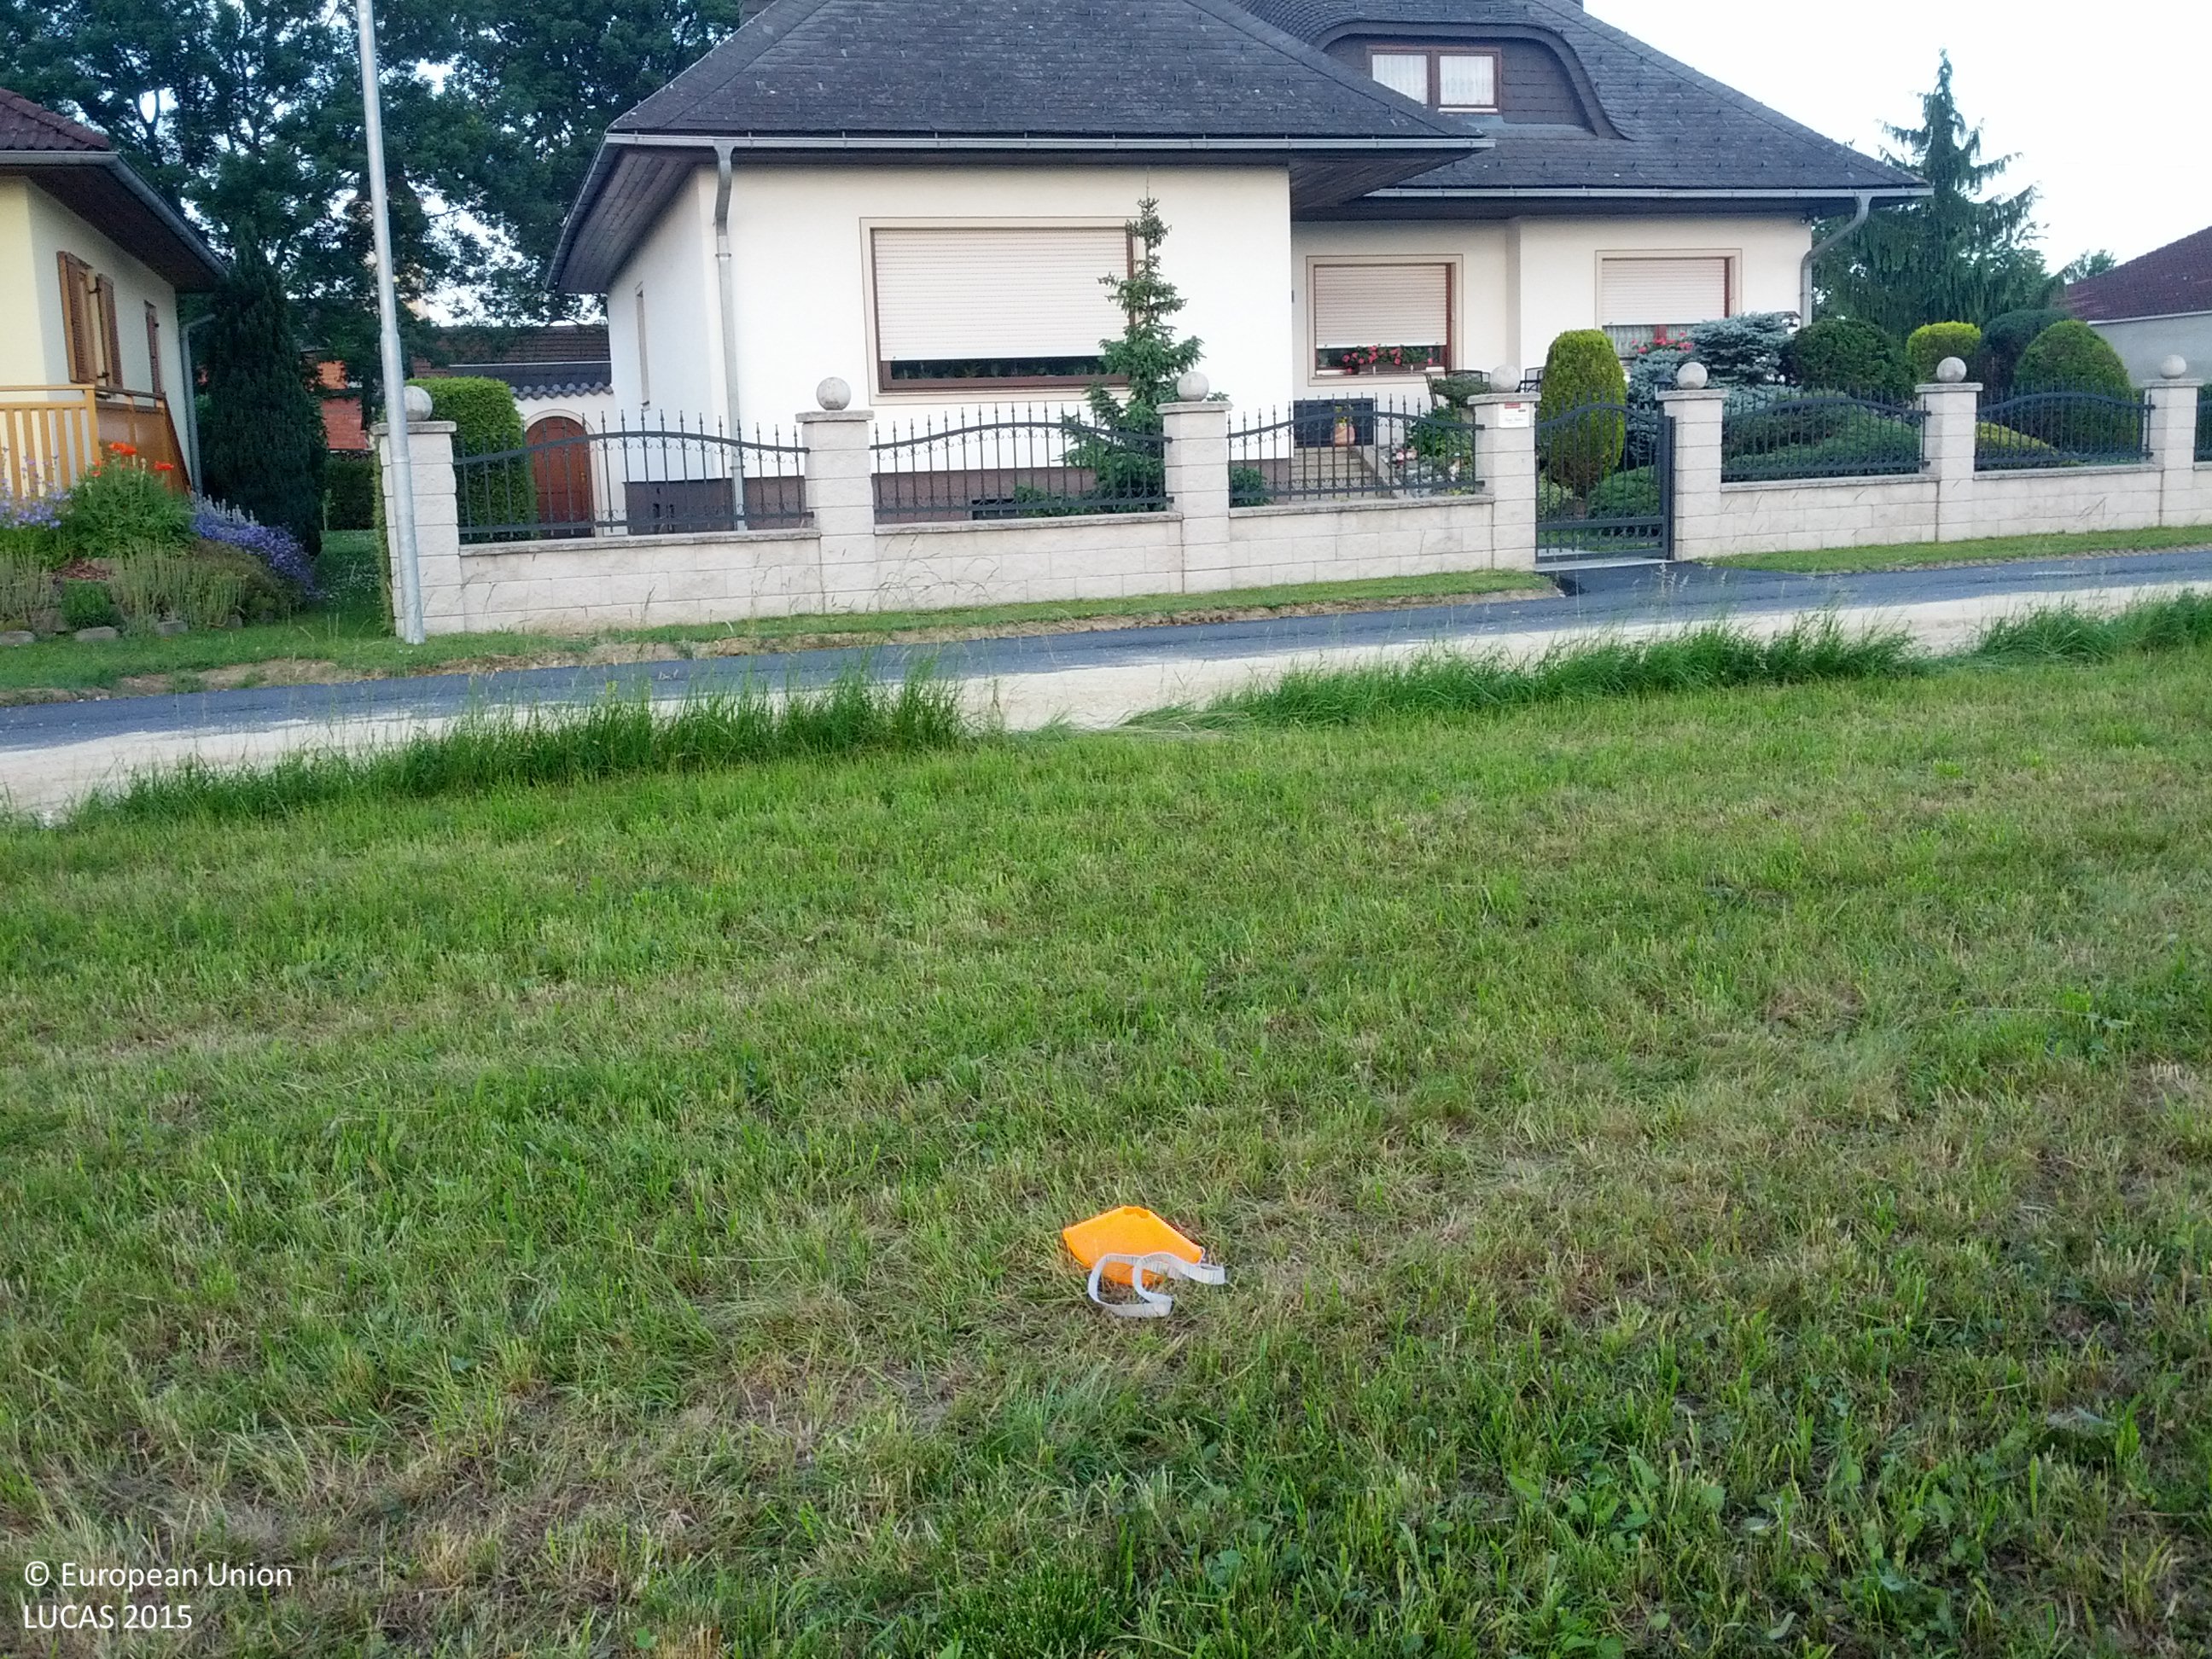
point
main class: Grassland
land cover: Grassland without tree/shrub cover
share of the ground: > 75 %
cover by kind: herbaceous plants 100 %
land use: Agriculture (excluding fallow land and kitchen gardens)
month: June
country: AT
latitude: 47.0438
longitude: 16.4122
